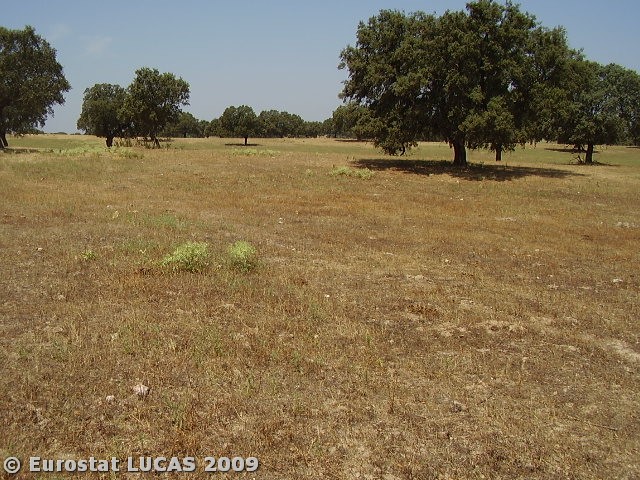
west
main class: Woodland
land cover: Broadleaved woodland
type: broadleaved evergreen forest
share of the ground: 10 - 25 %
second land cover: Spontaneously vegetated surfaces
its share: > 75 %
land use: Forestry
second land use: Fallow land
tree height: > 5 m
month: June
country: PT
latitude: 38.8483
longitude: -7.9867
